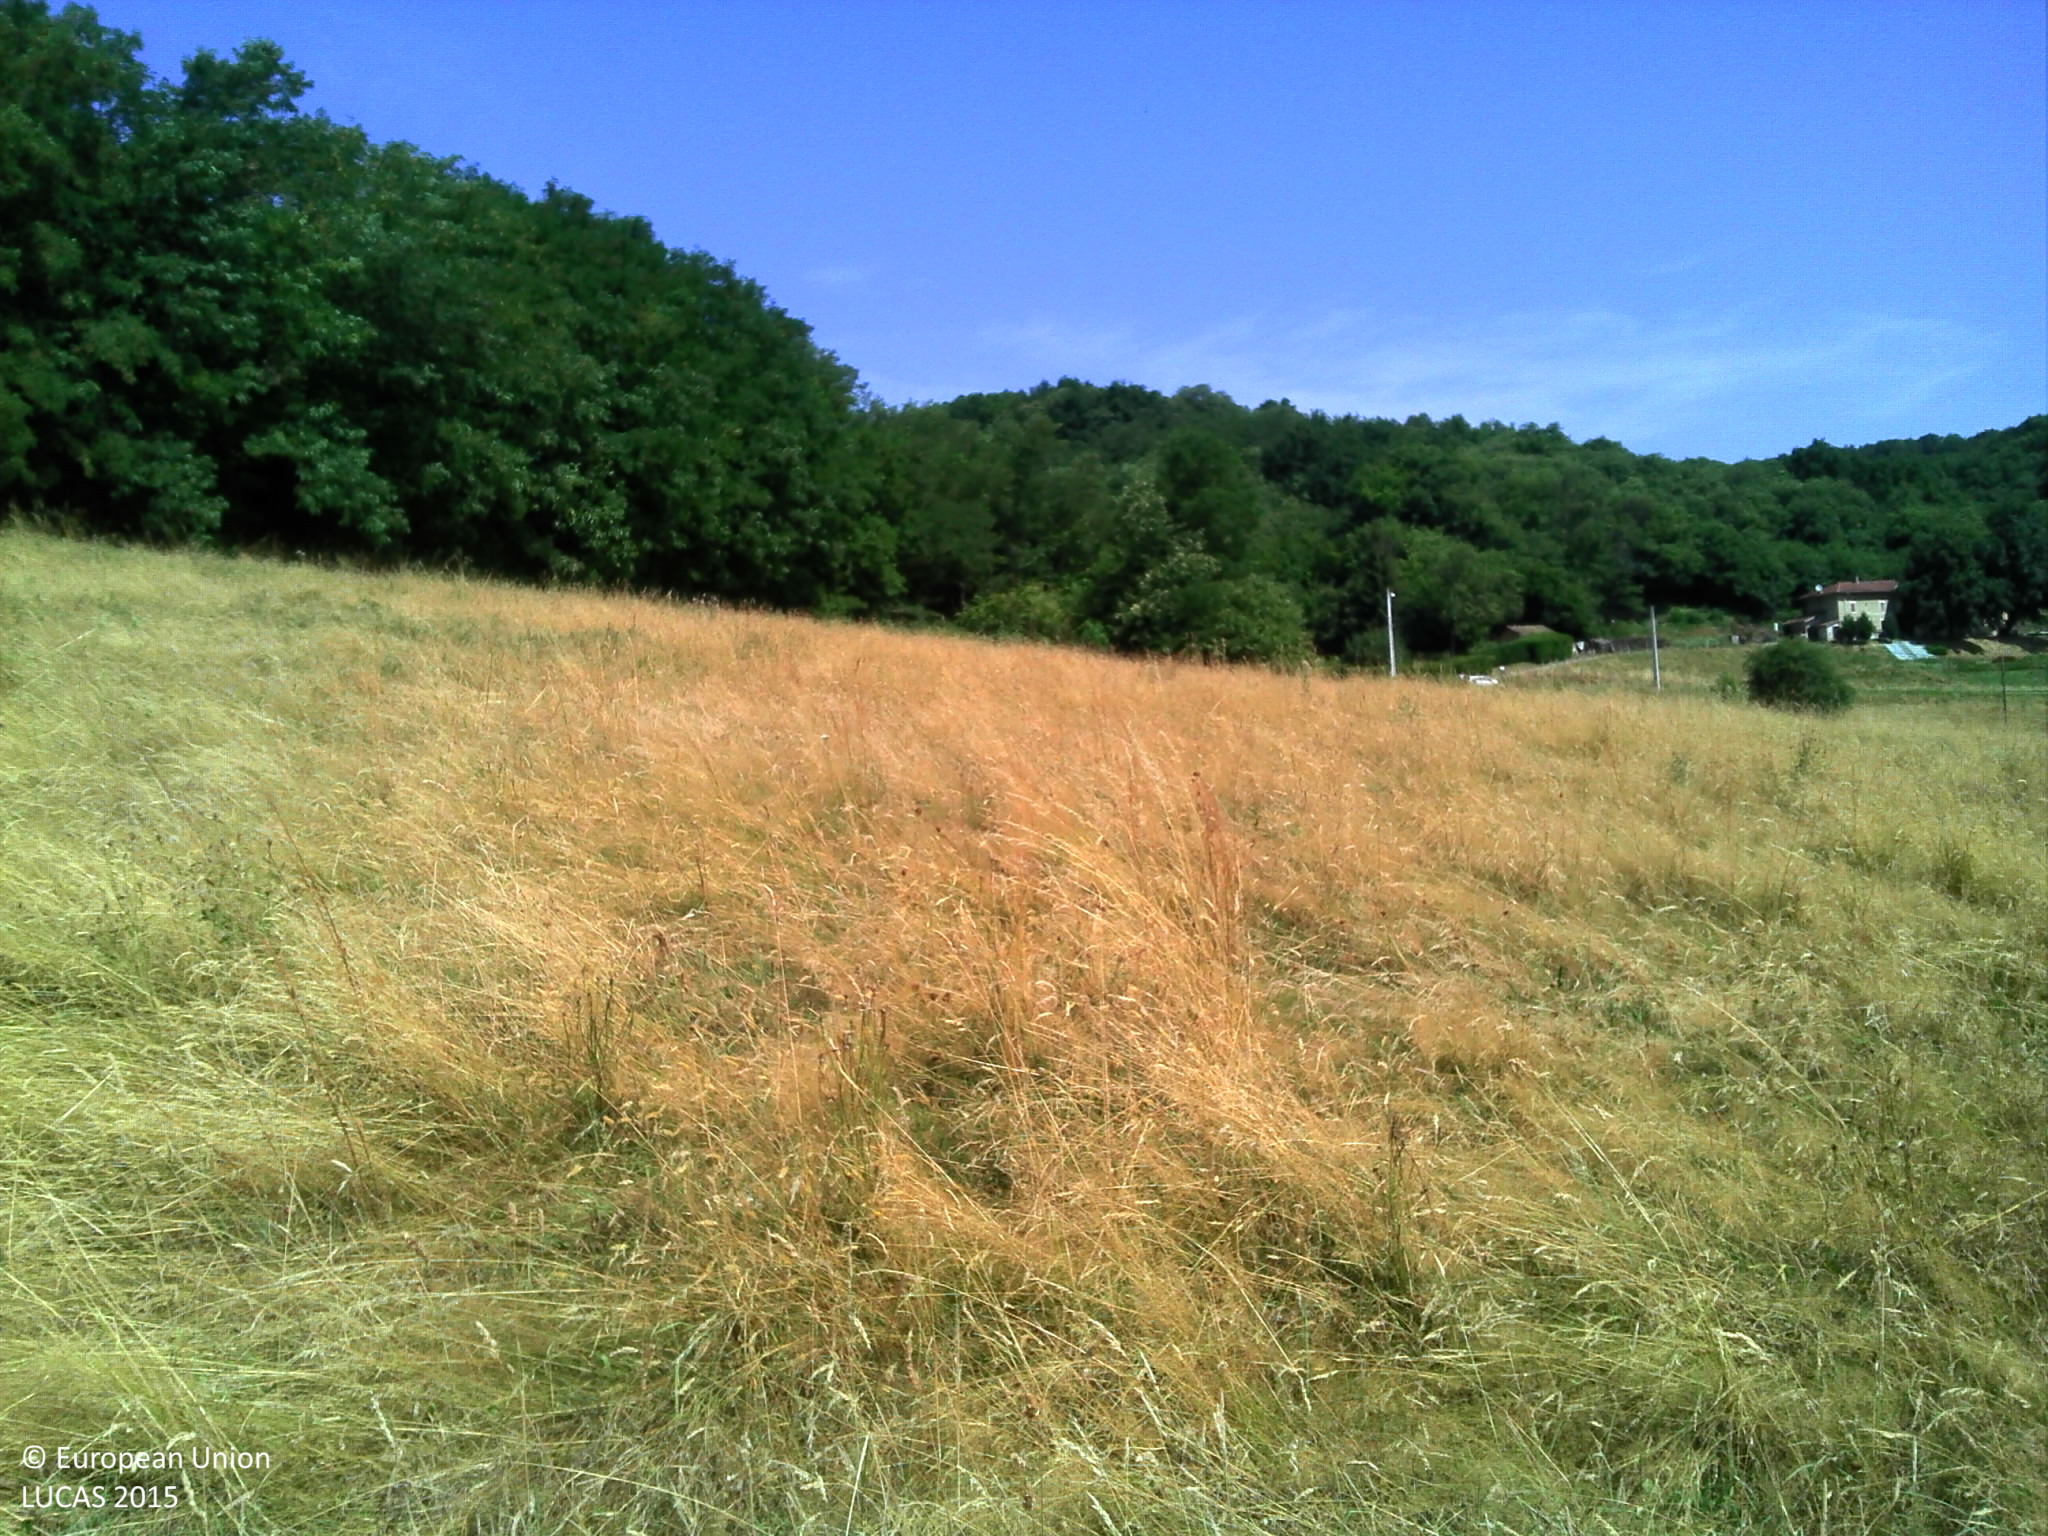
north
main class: Grassland
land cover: Grassland without tree/shrub cover
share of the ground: > 75 %
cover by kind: herbaceous plants 100 %
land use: Agriculture (excluding fallow land and kitchen gardens)
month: July
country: FR
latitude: 45.4307
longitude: 5.1858
